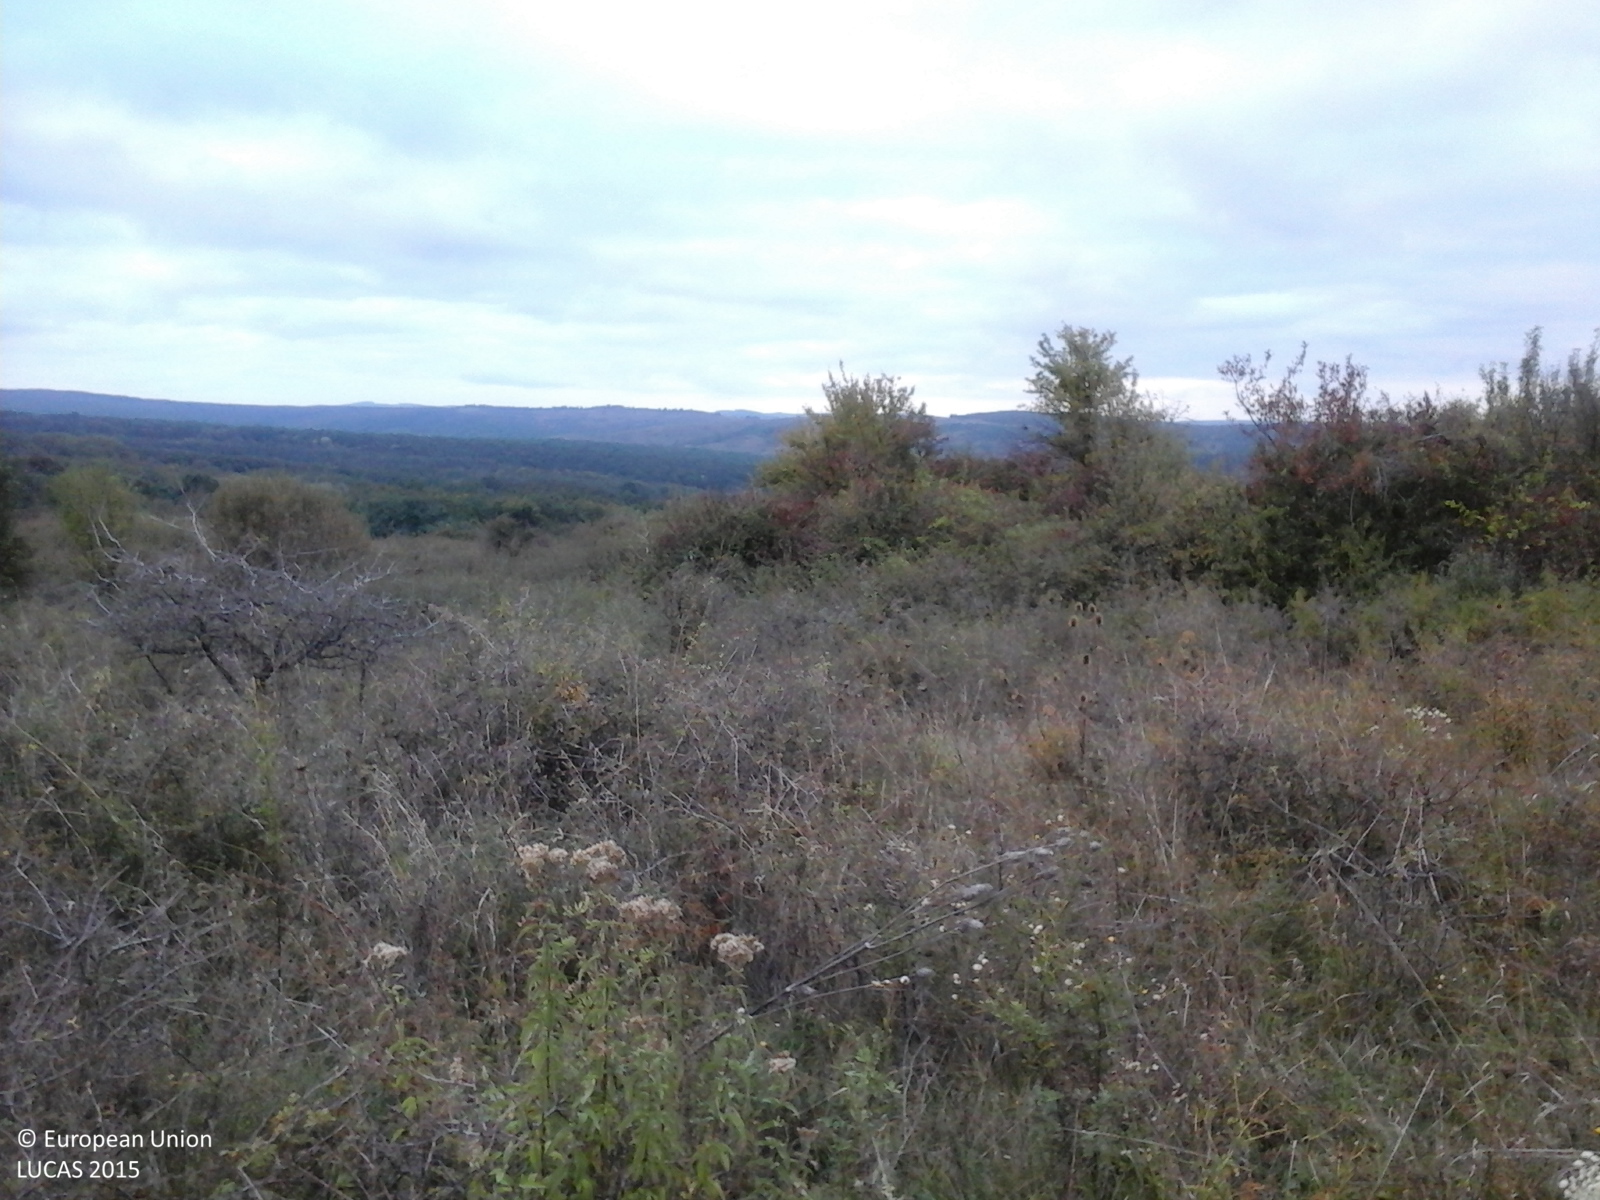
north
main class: Shrubland
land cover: Shrubland without tree cover
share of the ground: > 75 %
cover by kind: shrubs 100 %
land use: Semi-natural and natural areas not in use
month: October
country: RO
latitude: 45.9748
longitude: 24.7896
